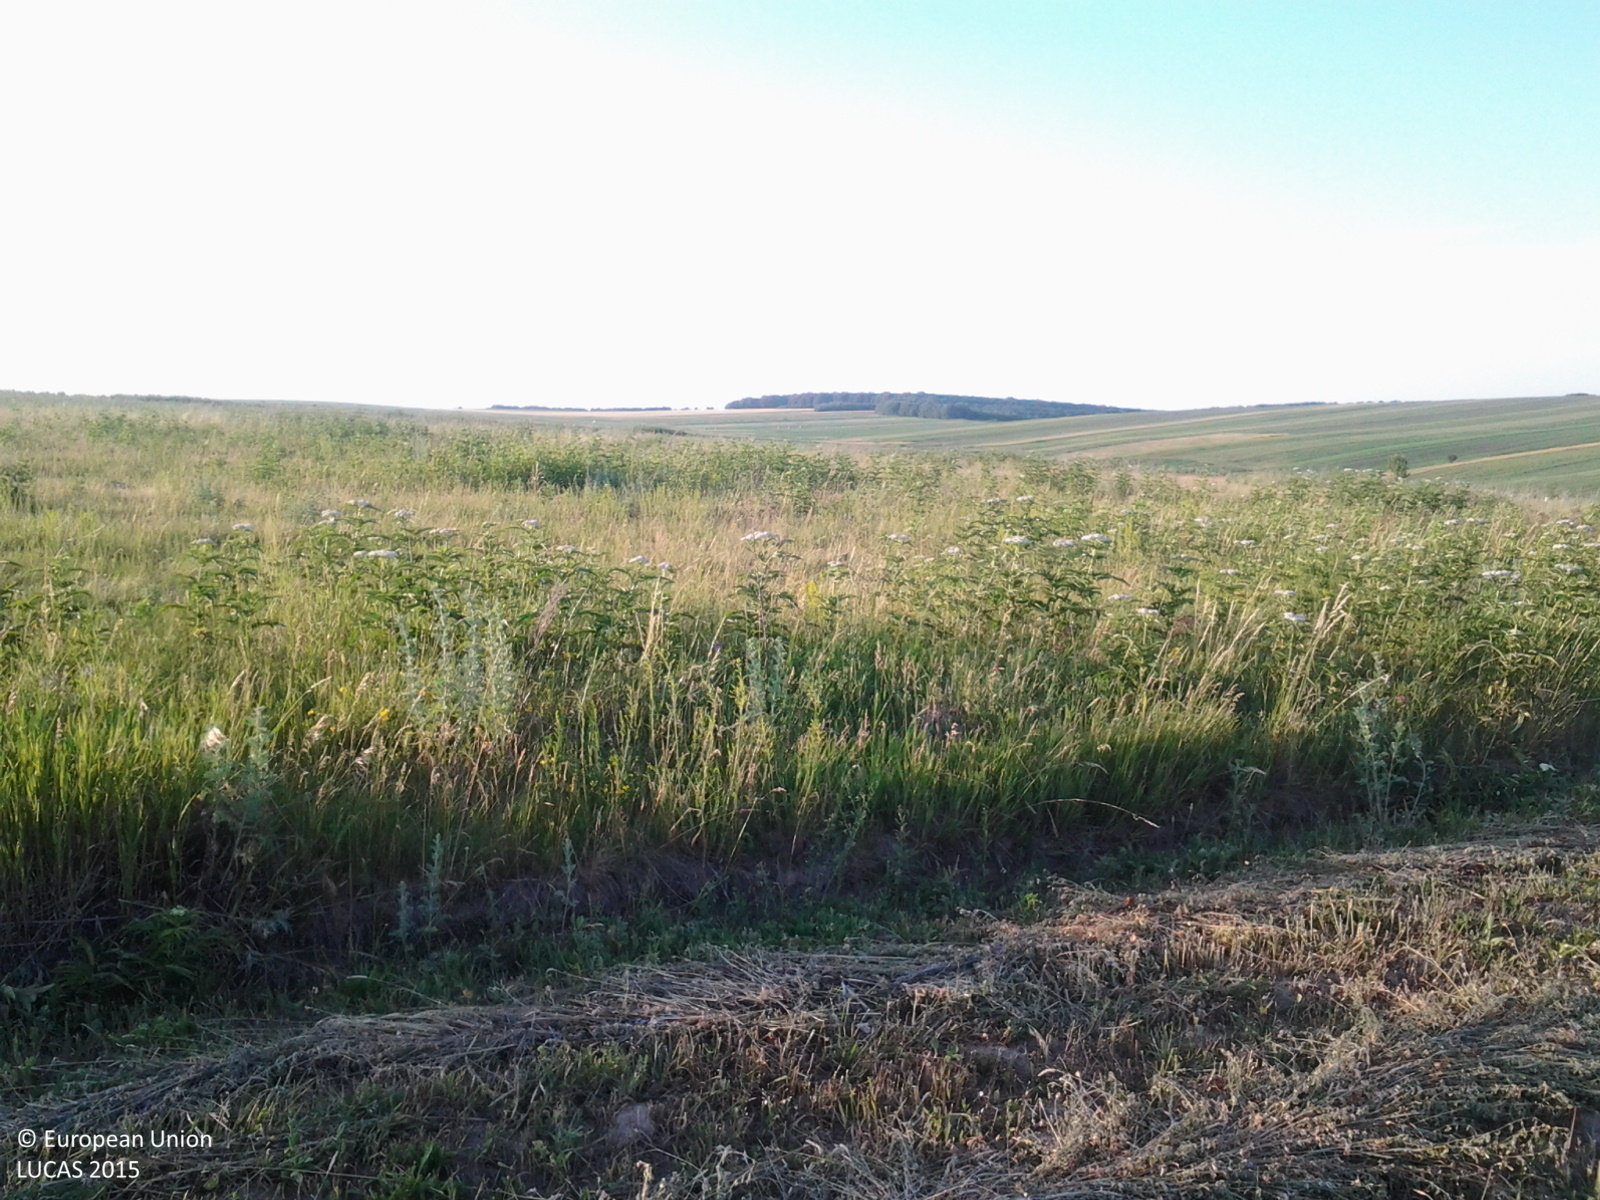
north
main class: Grassland
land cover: Grassland without tree/shrub cover
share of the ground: > 75 %
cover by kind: herbaceous plants 100 %
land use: Agriculture (excluding fallow land and kitchen gardens)
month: June
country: RO
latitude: 47.7350
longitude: 26.5330
